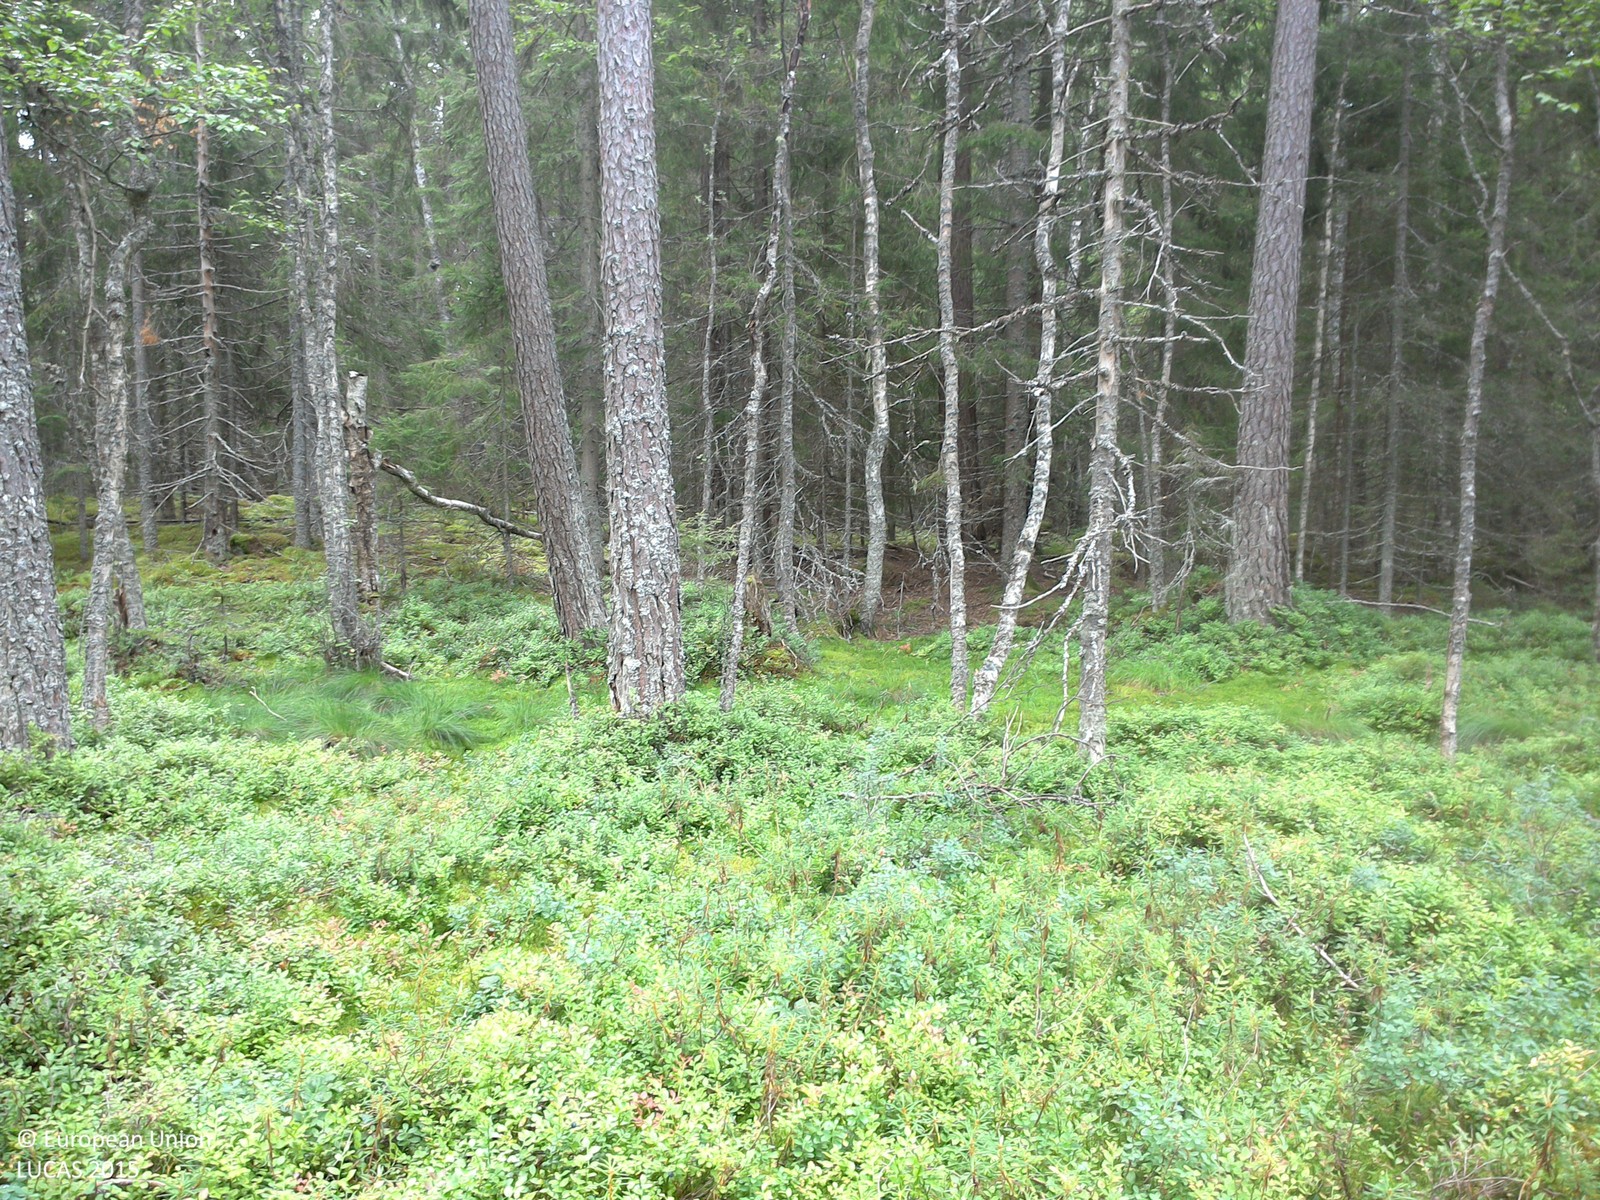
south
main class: Woodland
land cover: Pine dominated mixed woodland
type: boreal forest
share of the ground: 25 - 50 %
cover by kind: herbaceous plants 45 %, coniferous forest trees 30 %, lichens and mosses 15 %, broadleaved forest trees 10 %
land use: Forestry
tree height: > 5 m
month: August
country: SE
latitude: 57.8198
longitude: 15.4672
